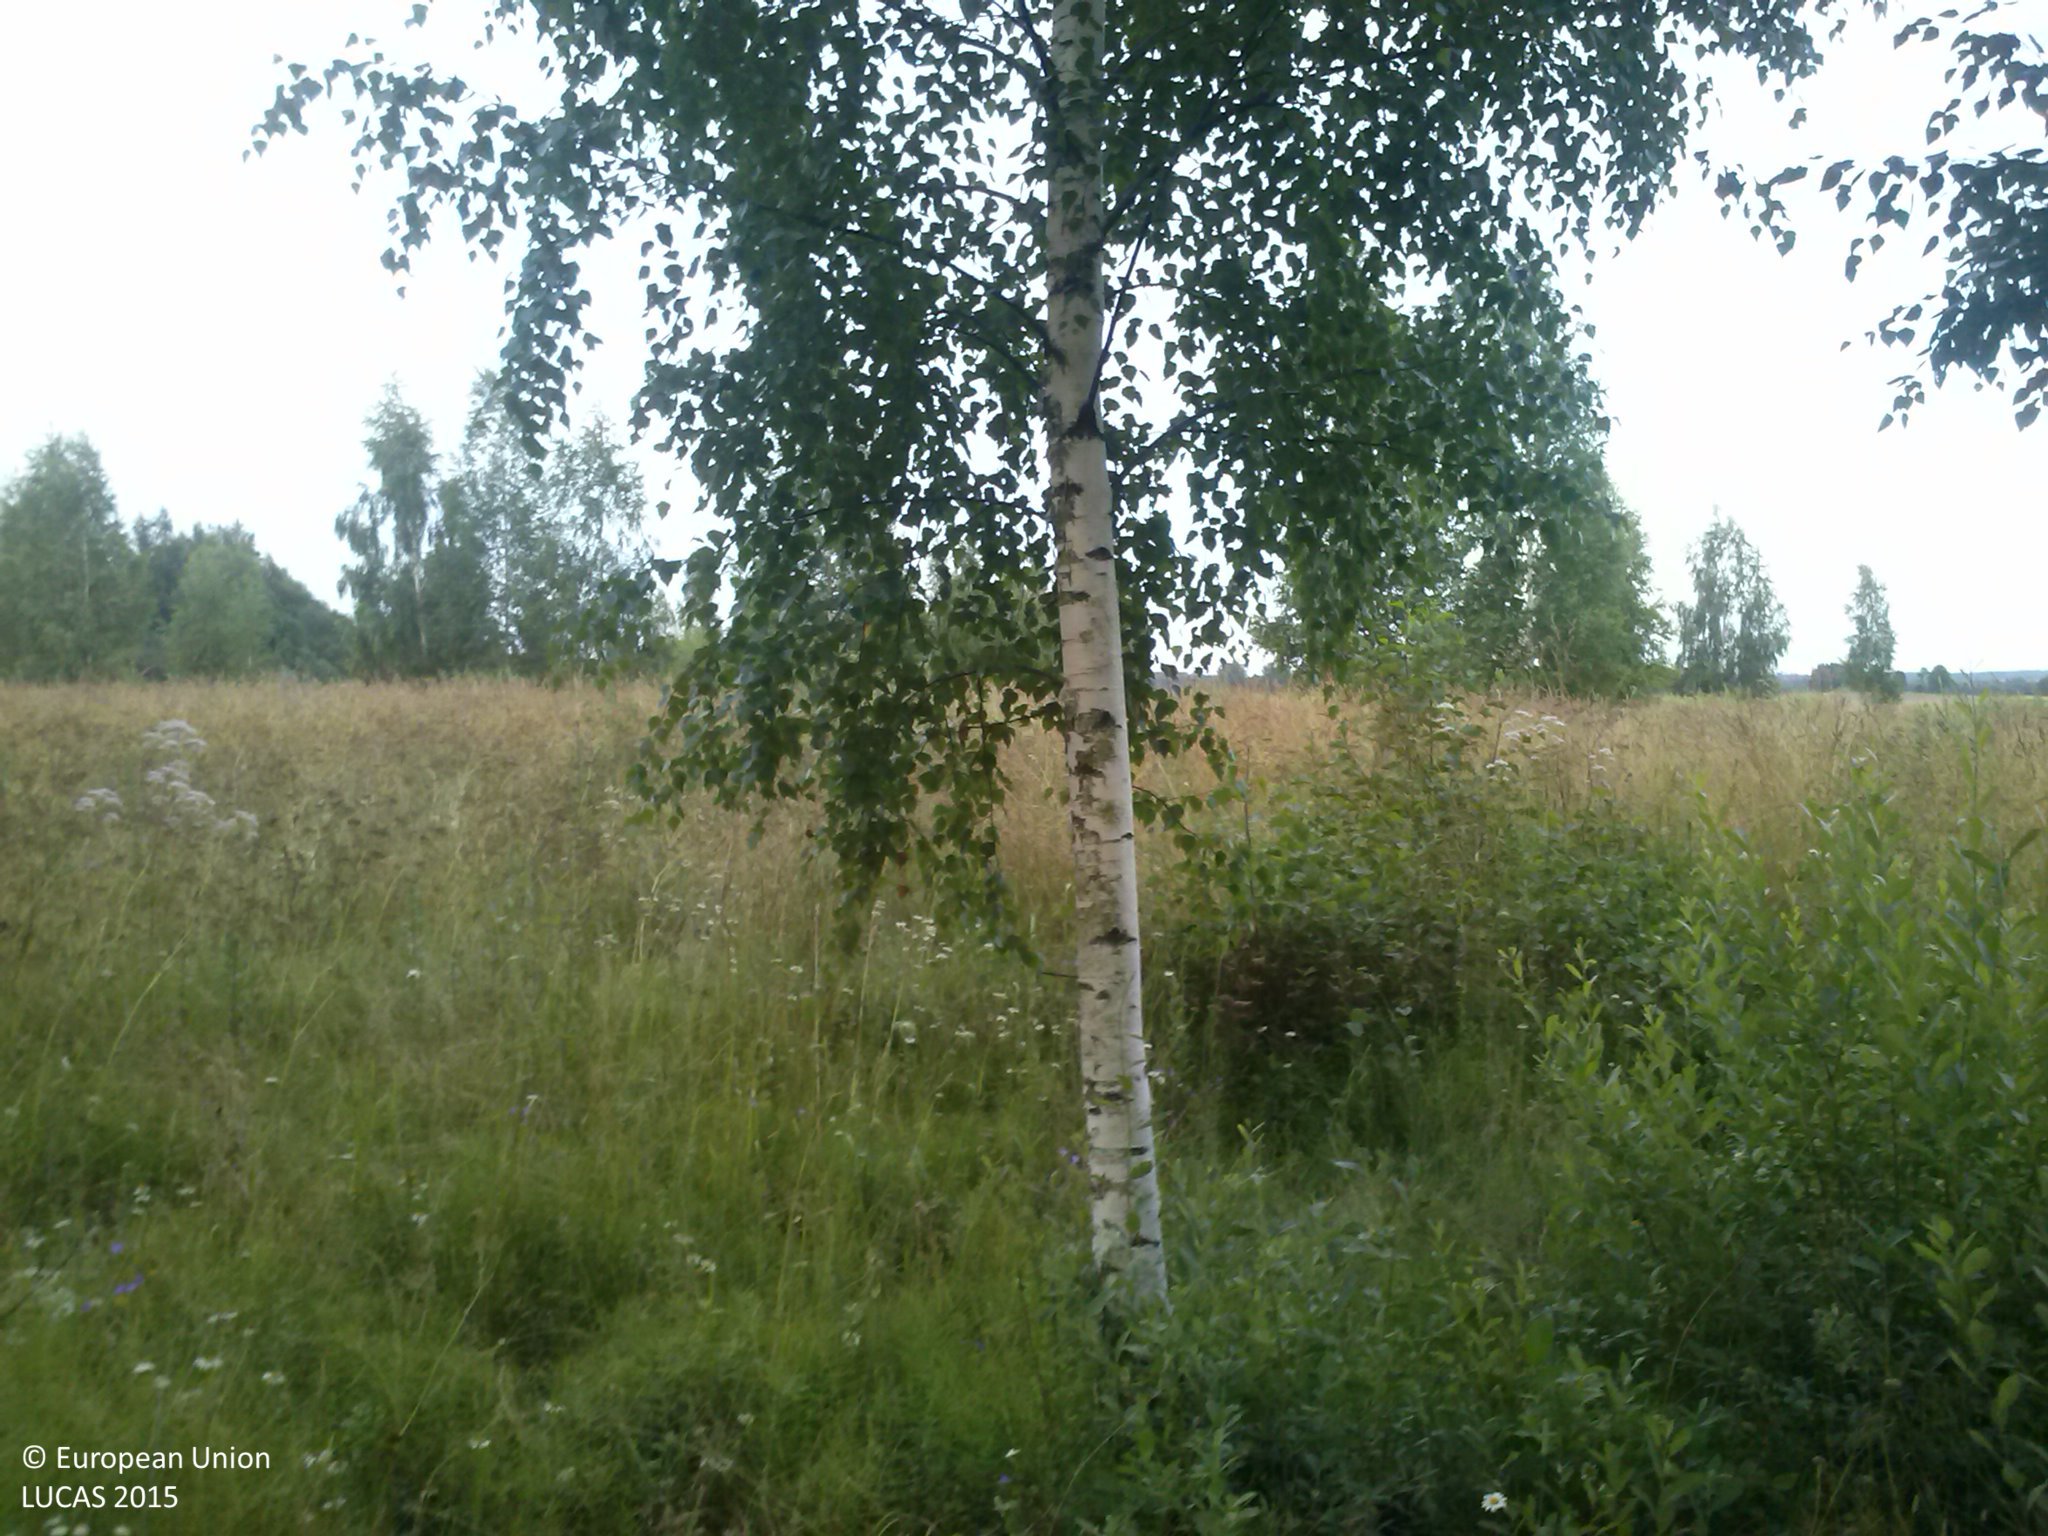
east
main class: Woodland
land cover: Broadleaved woodland
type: non-riverine alder, birch or aspen forest
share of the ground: 50 - 75 %
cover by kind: broadleaved forest trees 60 %, herbaceous plants 30 %
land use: Forestry
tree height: > 5 m
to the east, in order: Broadleaved woodland; Spontaneously vegetated surfaces; Grassland with sparse tree/shrub cover; Spontaneously vegetated surfaces; Tracks; Spontaneously vegetated surfaces; Barley
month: July
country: LV
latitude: 56.6694
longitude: 27.0870
